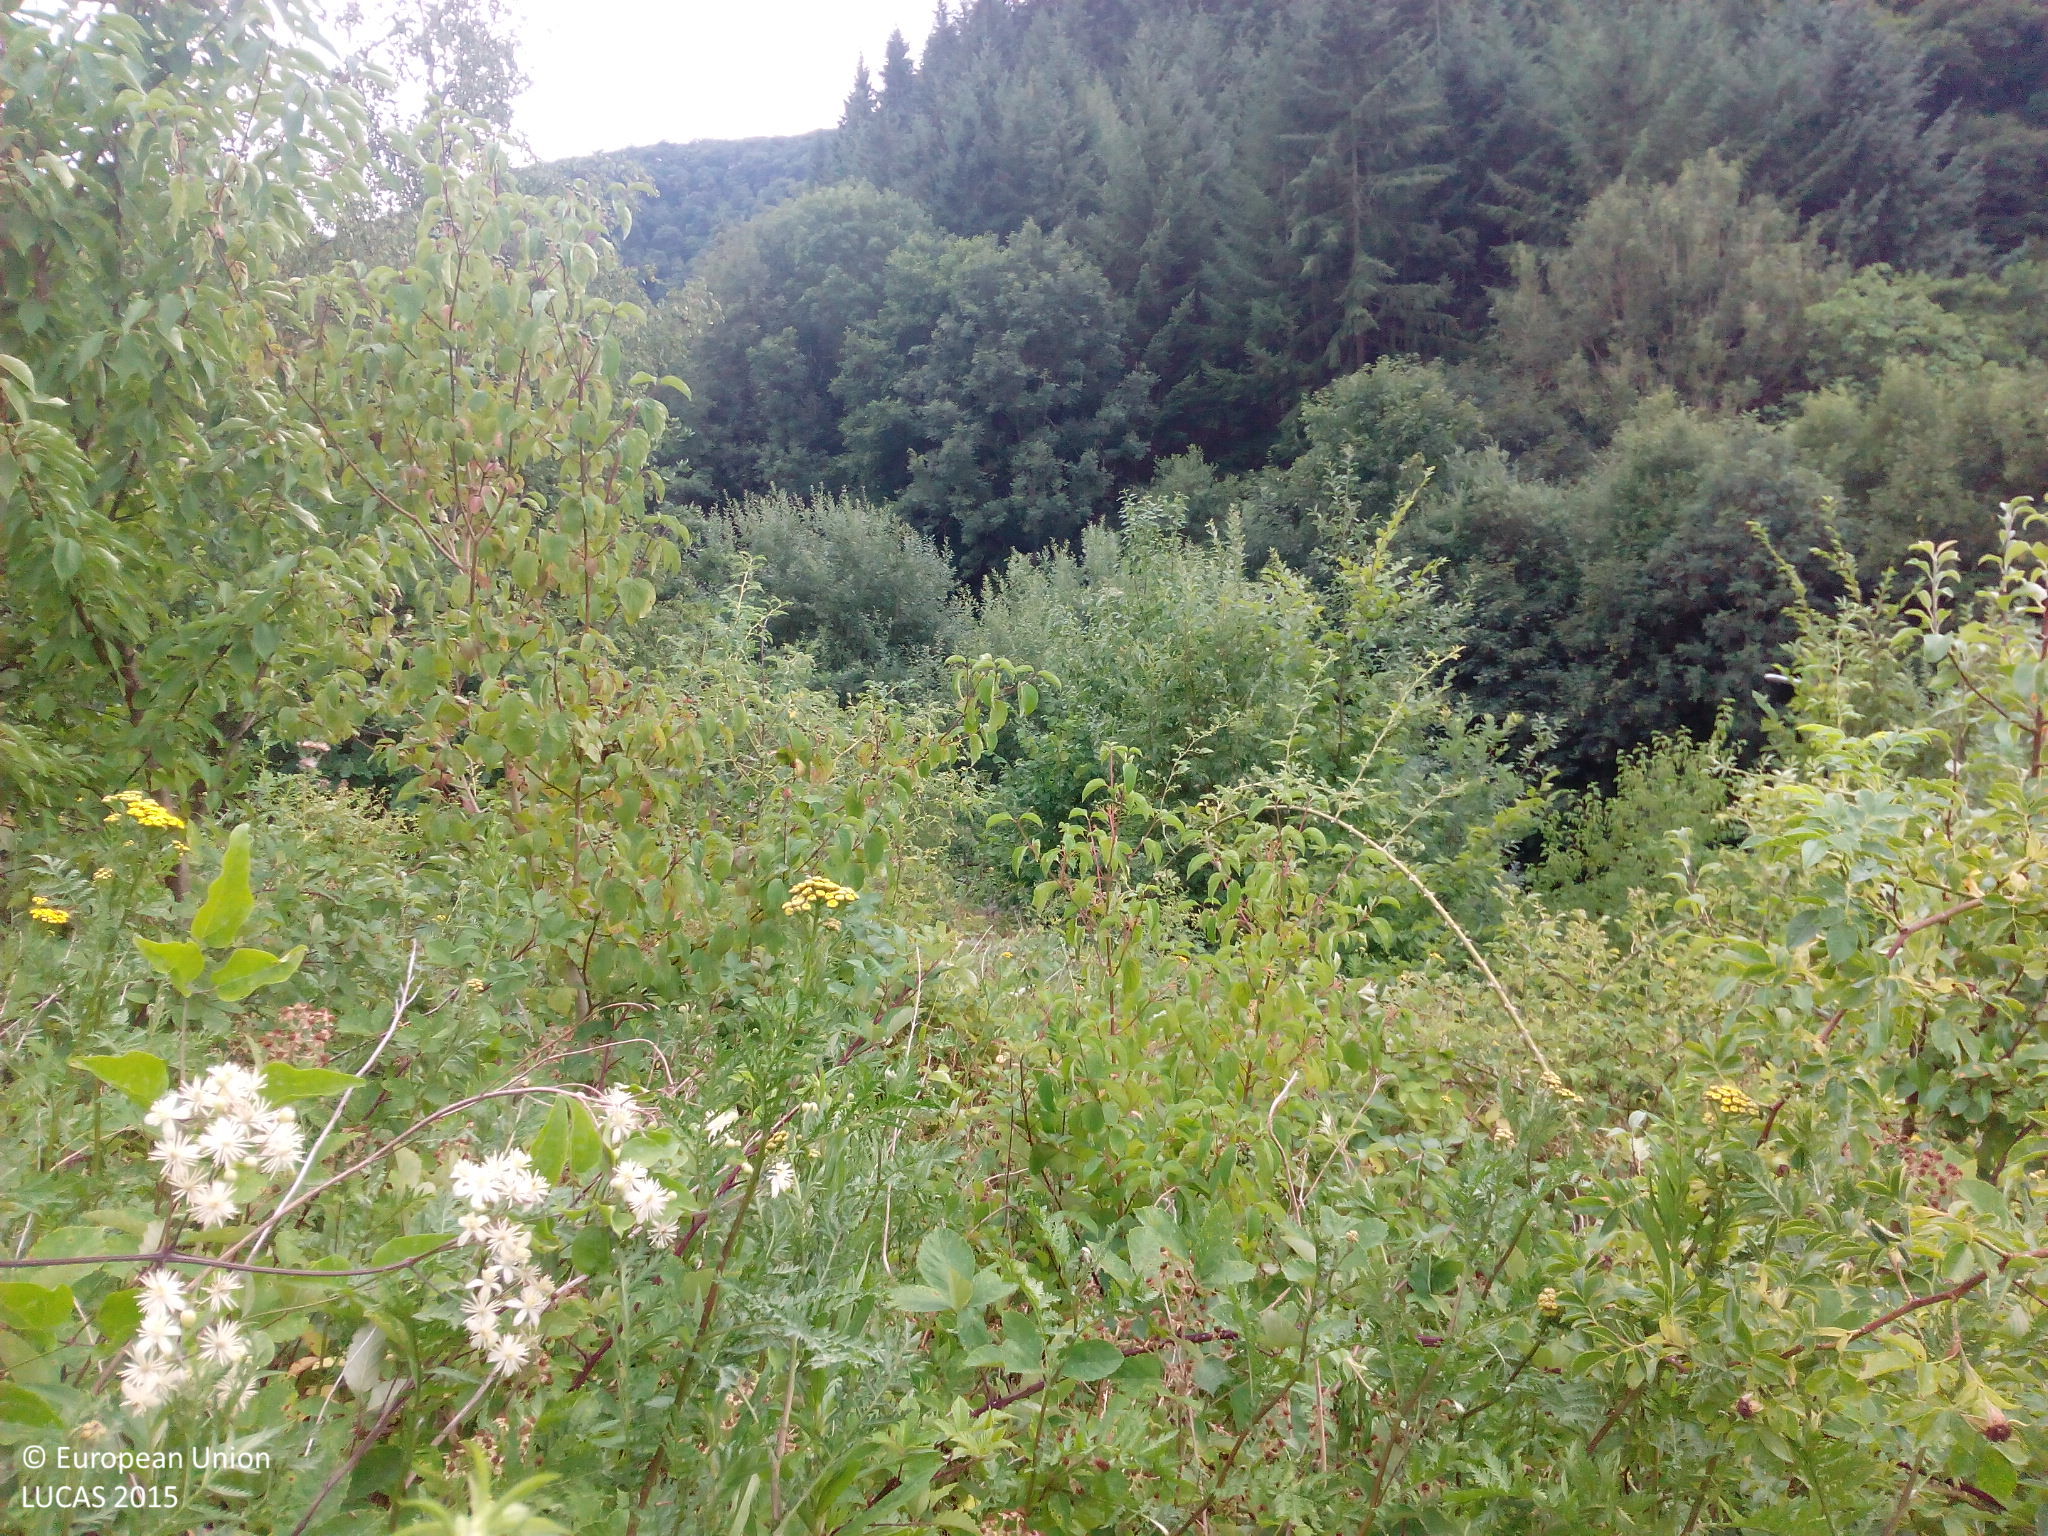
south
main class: Shrubland
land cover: Shrubland with sparse tree cover
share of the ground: > 75 %
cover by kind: shrubs 70 %, herbaceous plants 25 %, broadleaved forest trees 5 %
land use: Abandoned areas
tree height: < 5 m
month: July
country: DE
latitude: 49.9319
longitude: 7.1164
